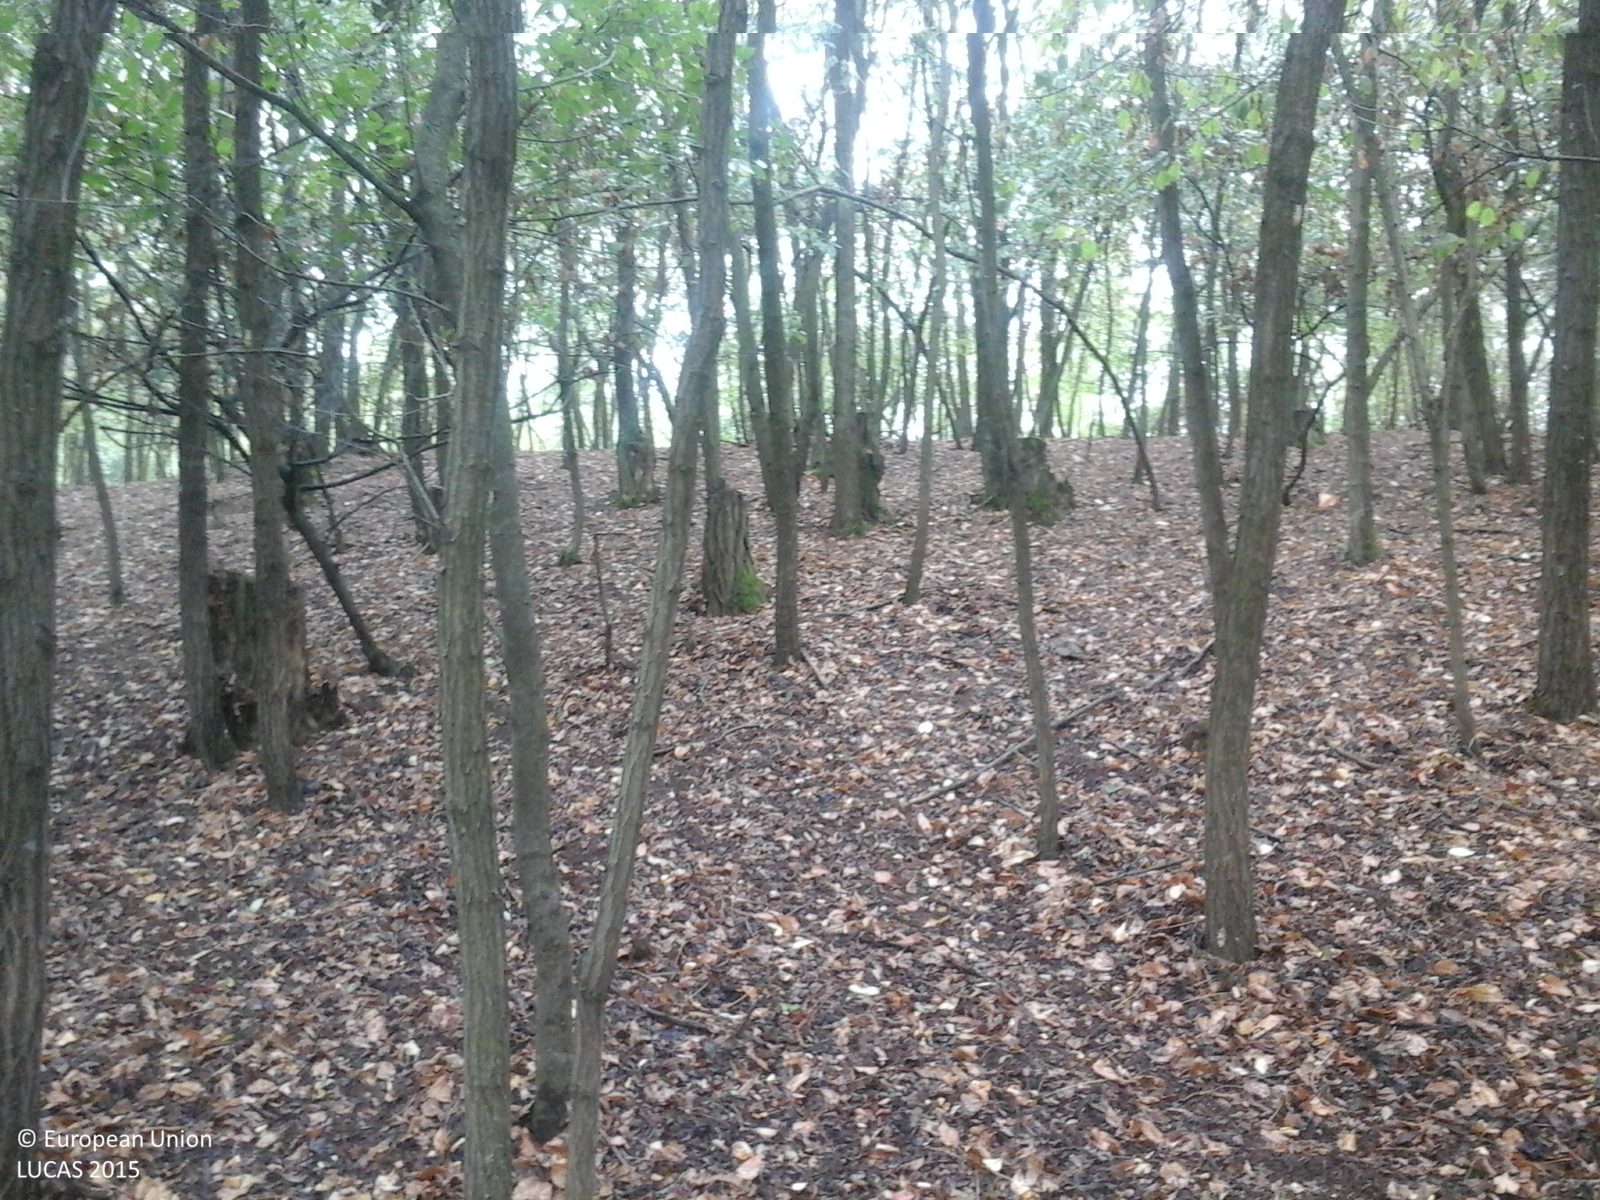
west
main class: Woodland
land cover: Broadleaved woodland
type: mesophytic deciduous forest
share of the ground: > 75 %
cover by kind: broadleaved forest trees 100 %
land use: Forestry
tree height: > 5 m
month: September
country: RO
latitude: 47.6630
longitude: 22.2654
